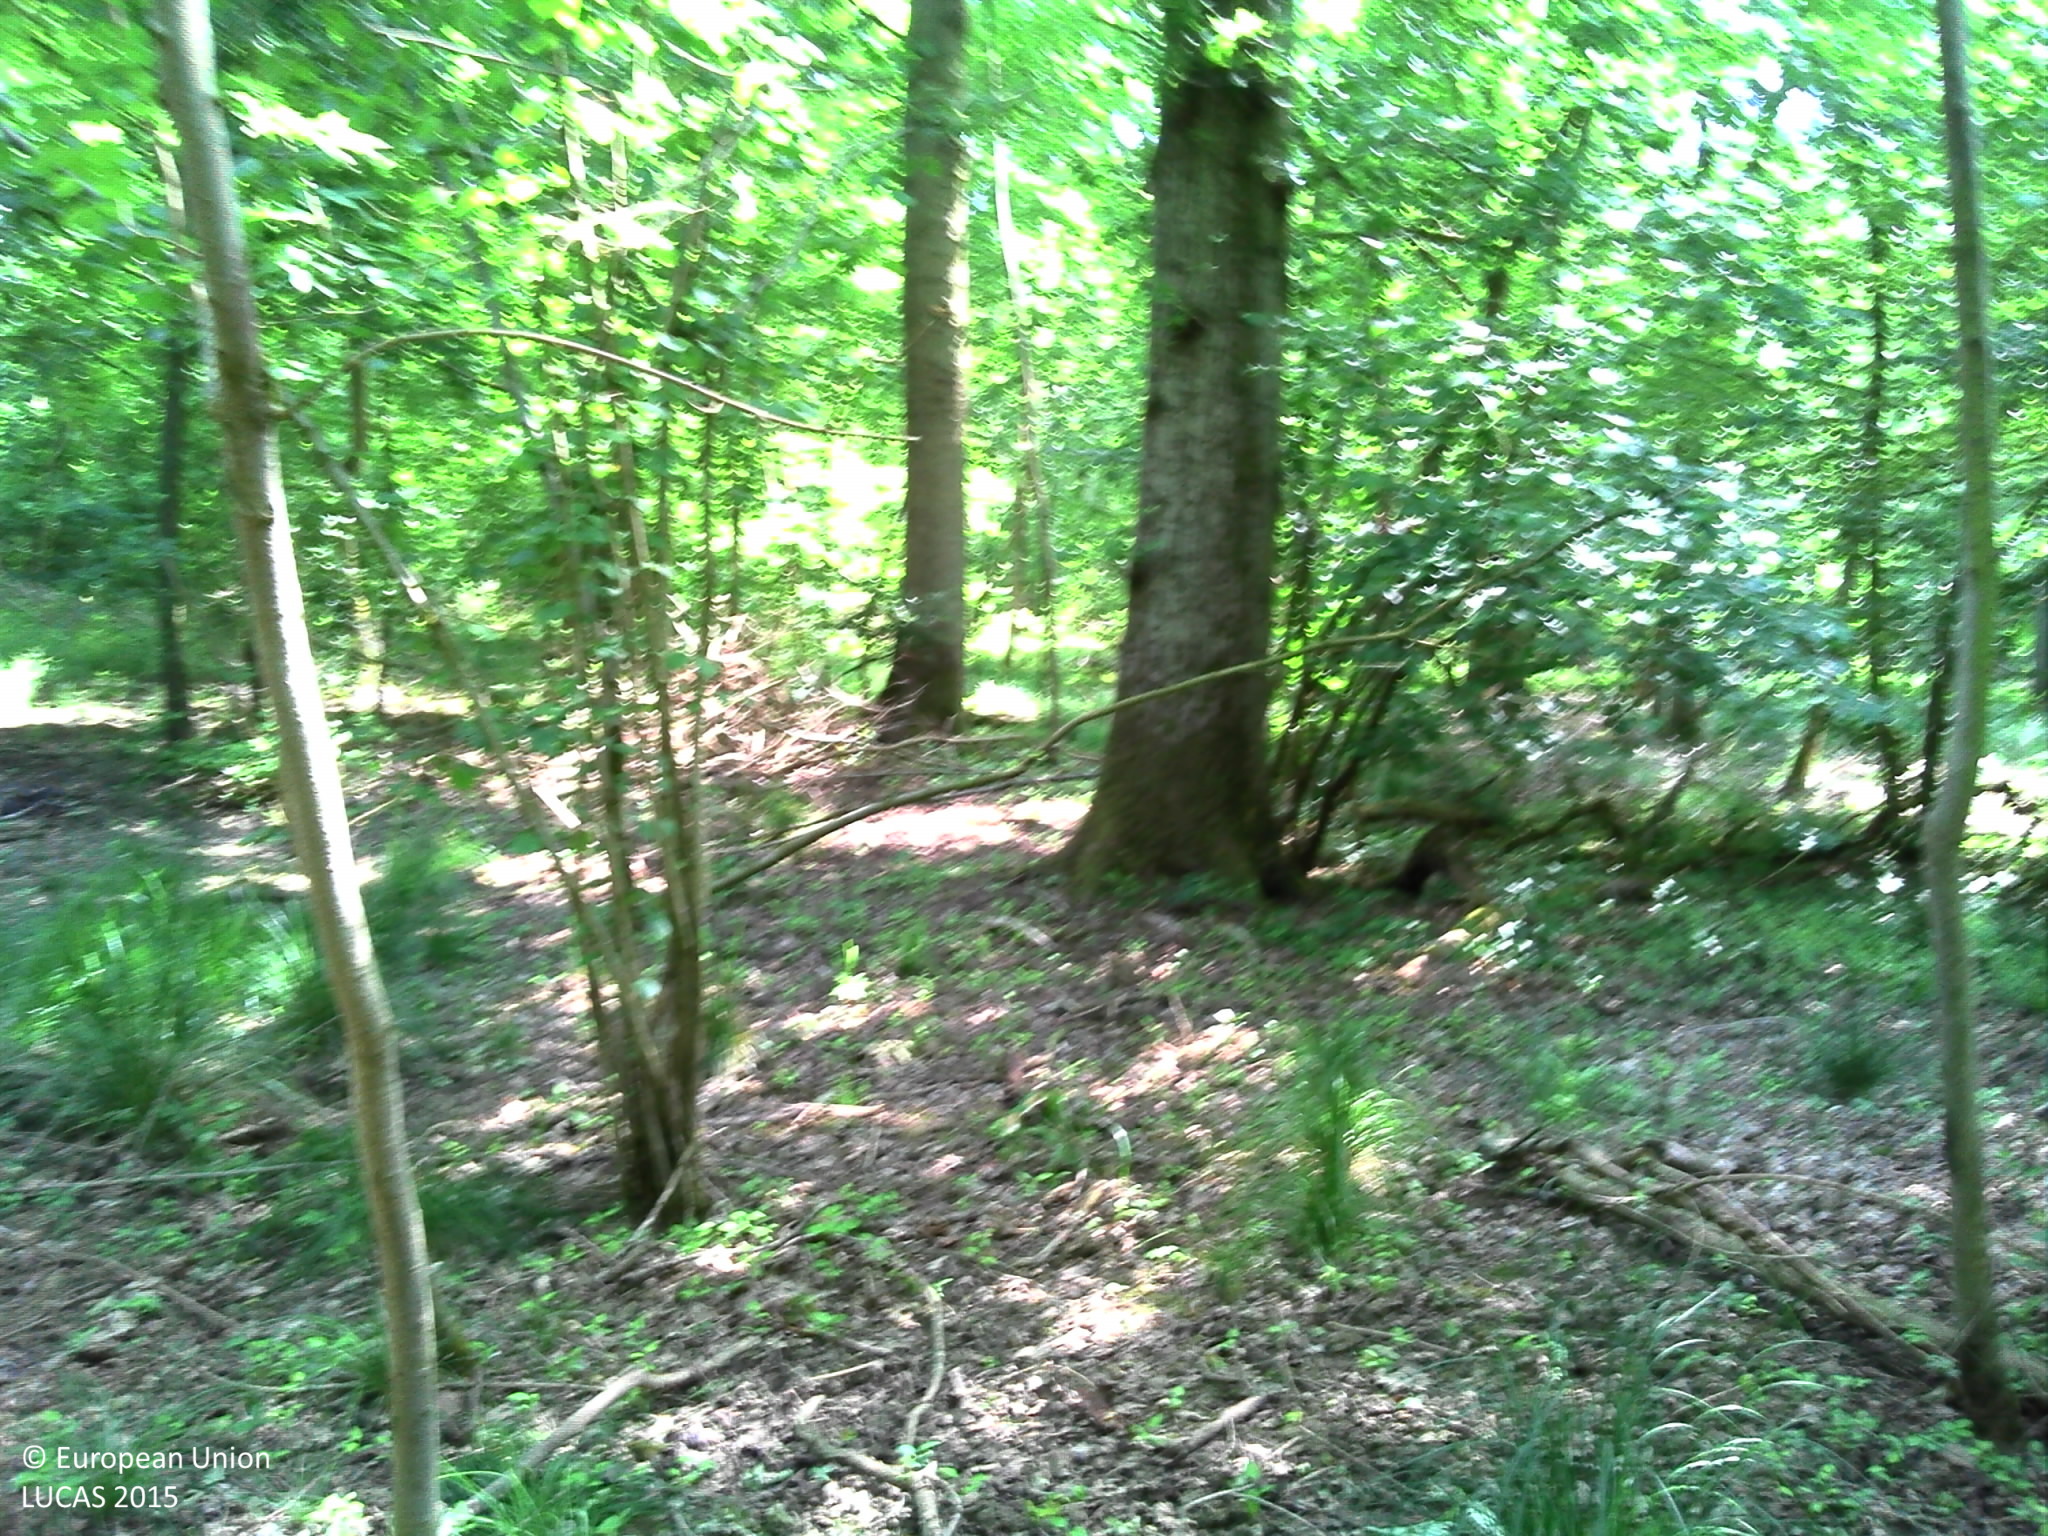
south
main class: Woodland
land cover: Broadleaved woodland
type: mesophytic deciduous forest
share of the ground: > 75 %
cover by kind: broadleaved forest trees 80 %, herbaceous plants 10 %
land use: Forestry
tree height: > 5 m
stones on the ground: < 10 %
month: June
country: FR
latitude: 50.7595
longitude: 2.3738
